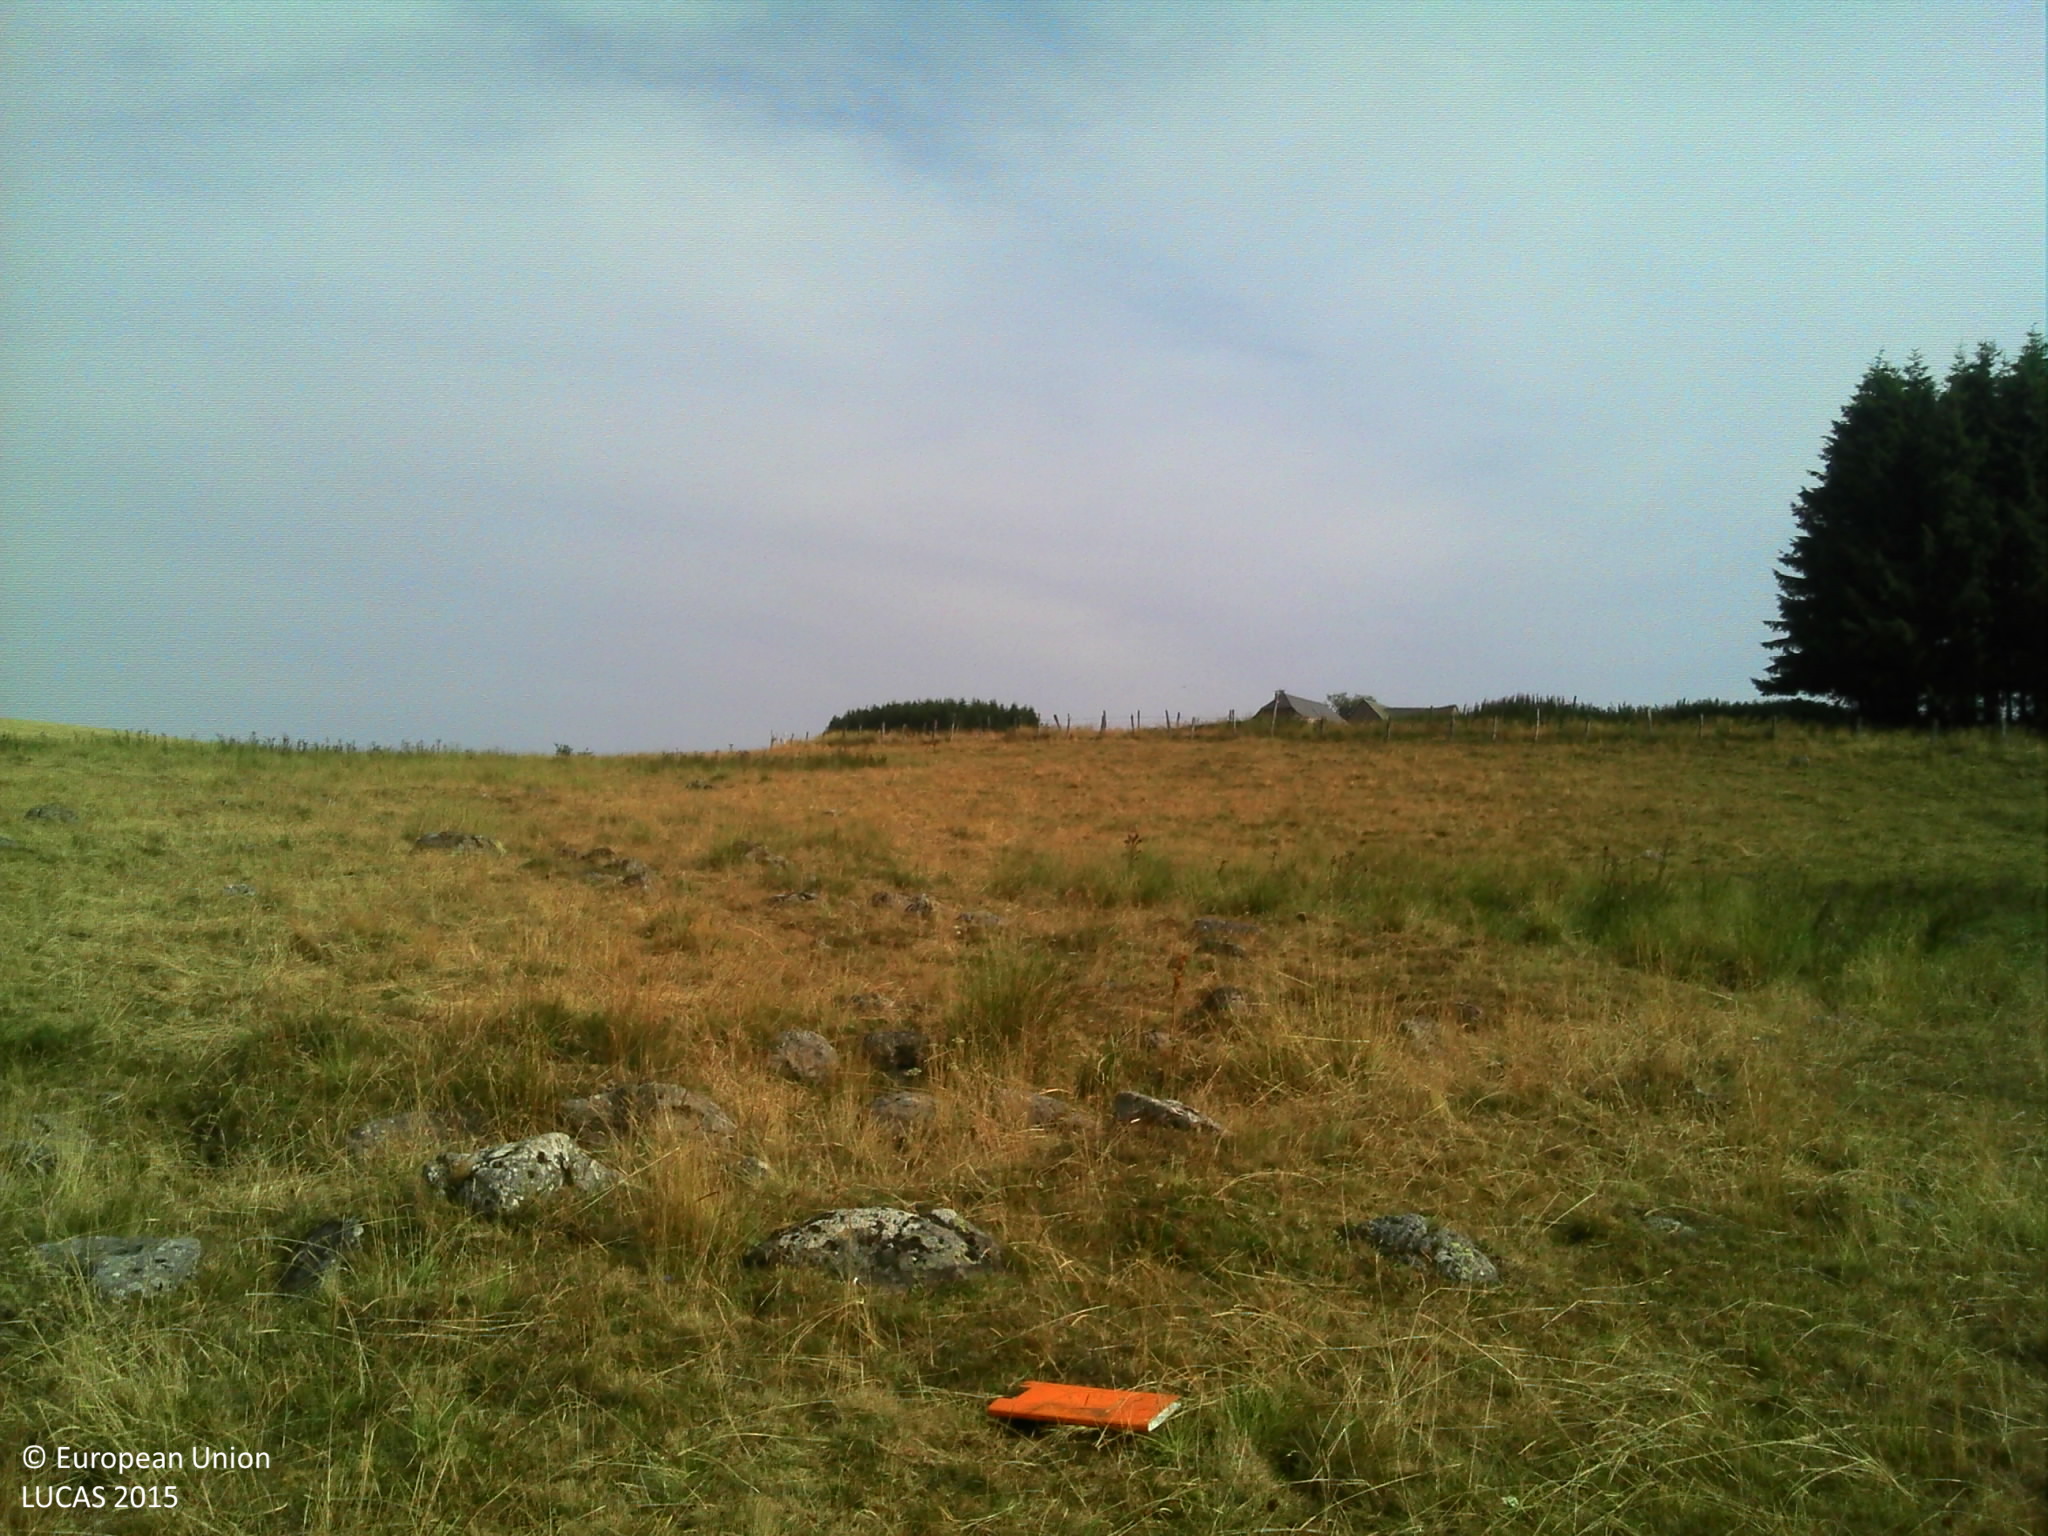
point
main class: Grassland
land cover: Grassland without tree/shrub cover
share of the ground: > 75 %
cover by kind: herbaceous plants 95 %, shrubs 5 %
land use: Agriculture (excluding fallow land and kitchen gardens)
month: July
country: FR
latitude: 44.6050
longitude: 3.0362
